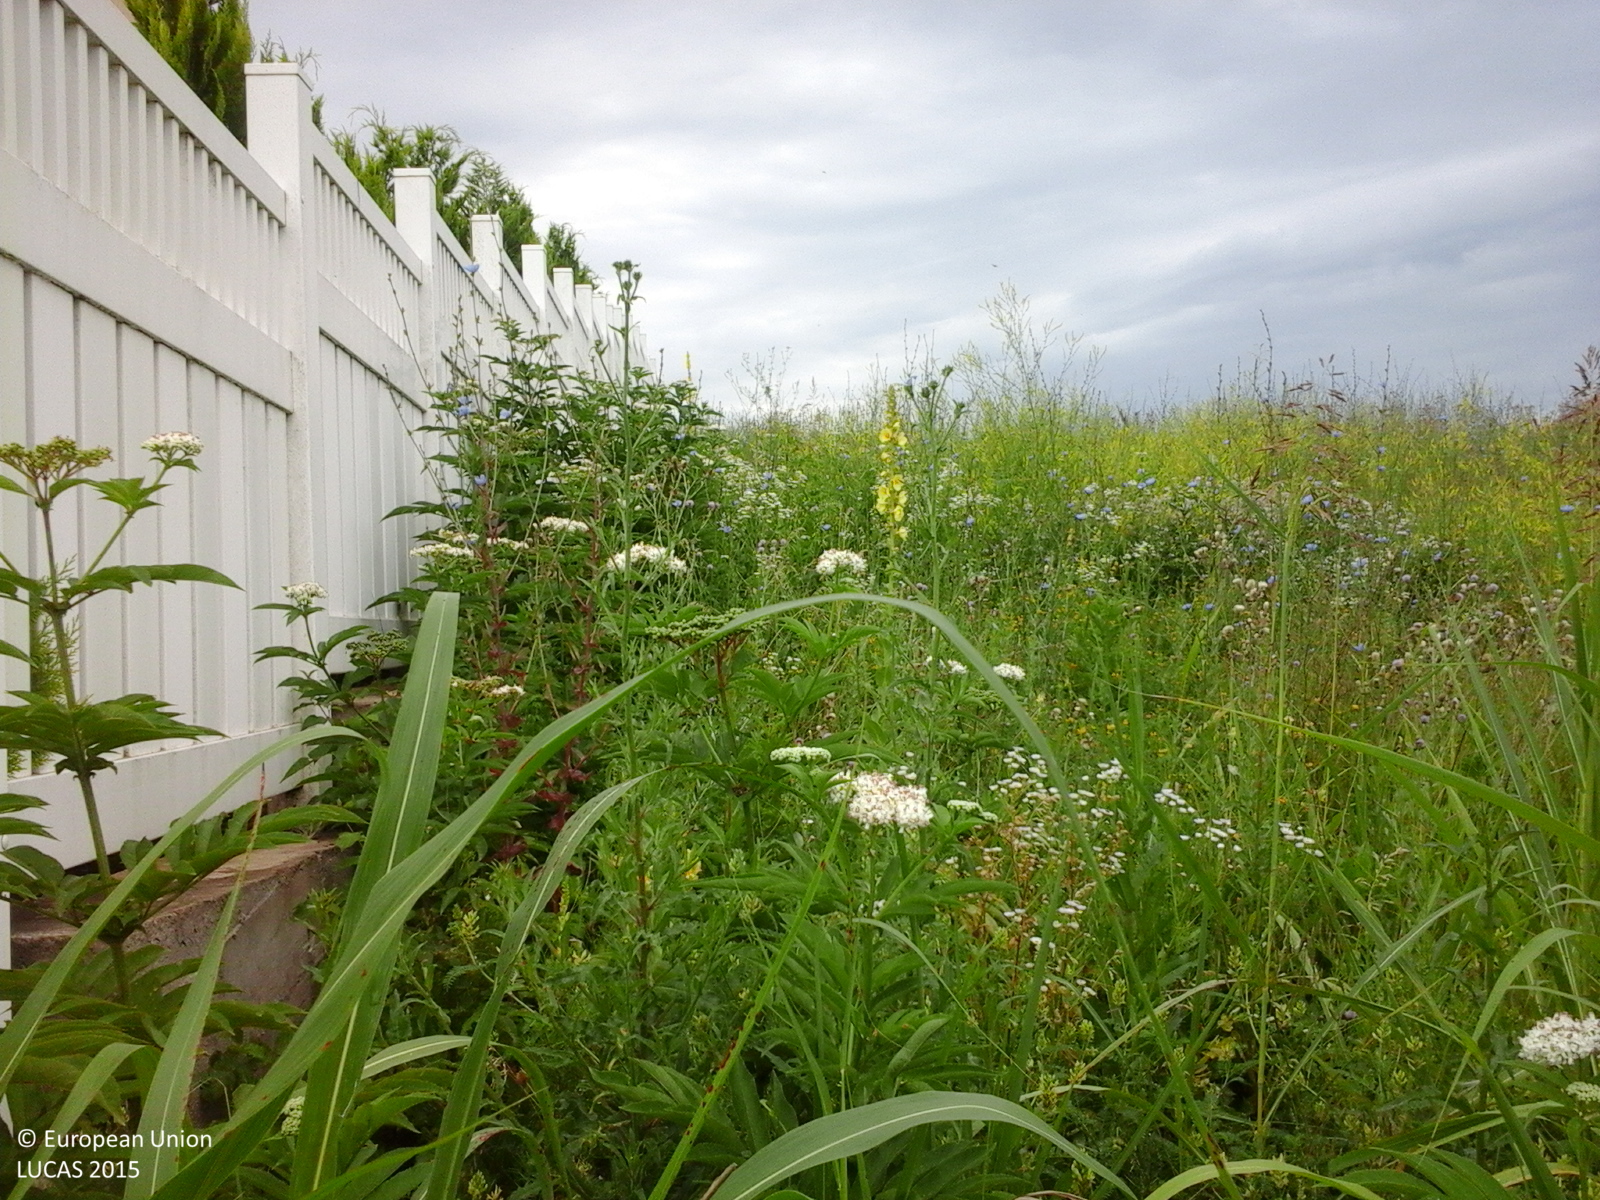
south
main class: Grassland
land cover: Grassland with sparse tree/shrub cover
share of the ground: > 75 %
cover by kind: herbaceous plants 95 %, coniferous forest trees 5 %
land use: Residential
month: June
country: RO
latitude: 44.6020
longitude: 26.0172
